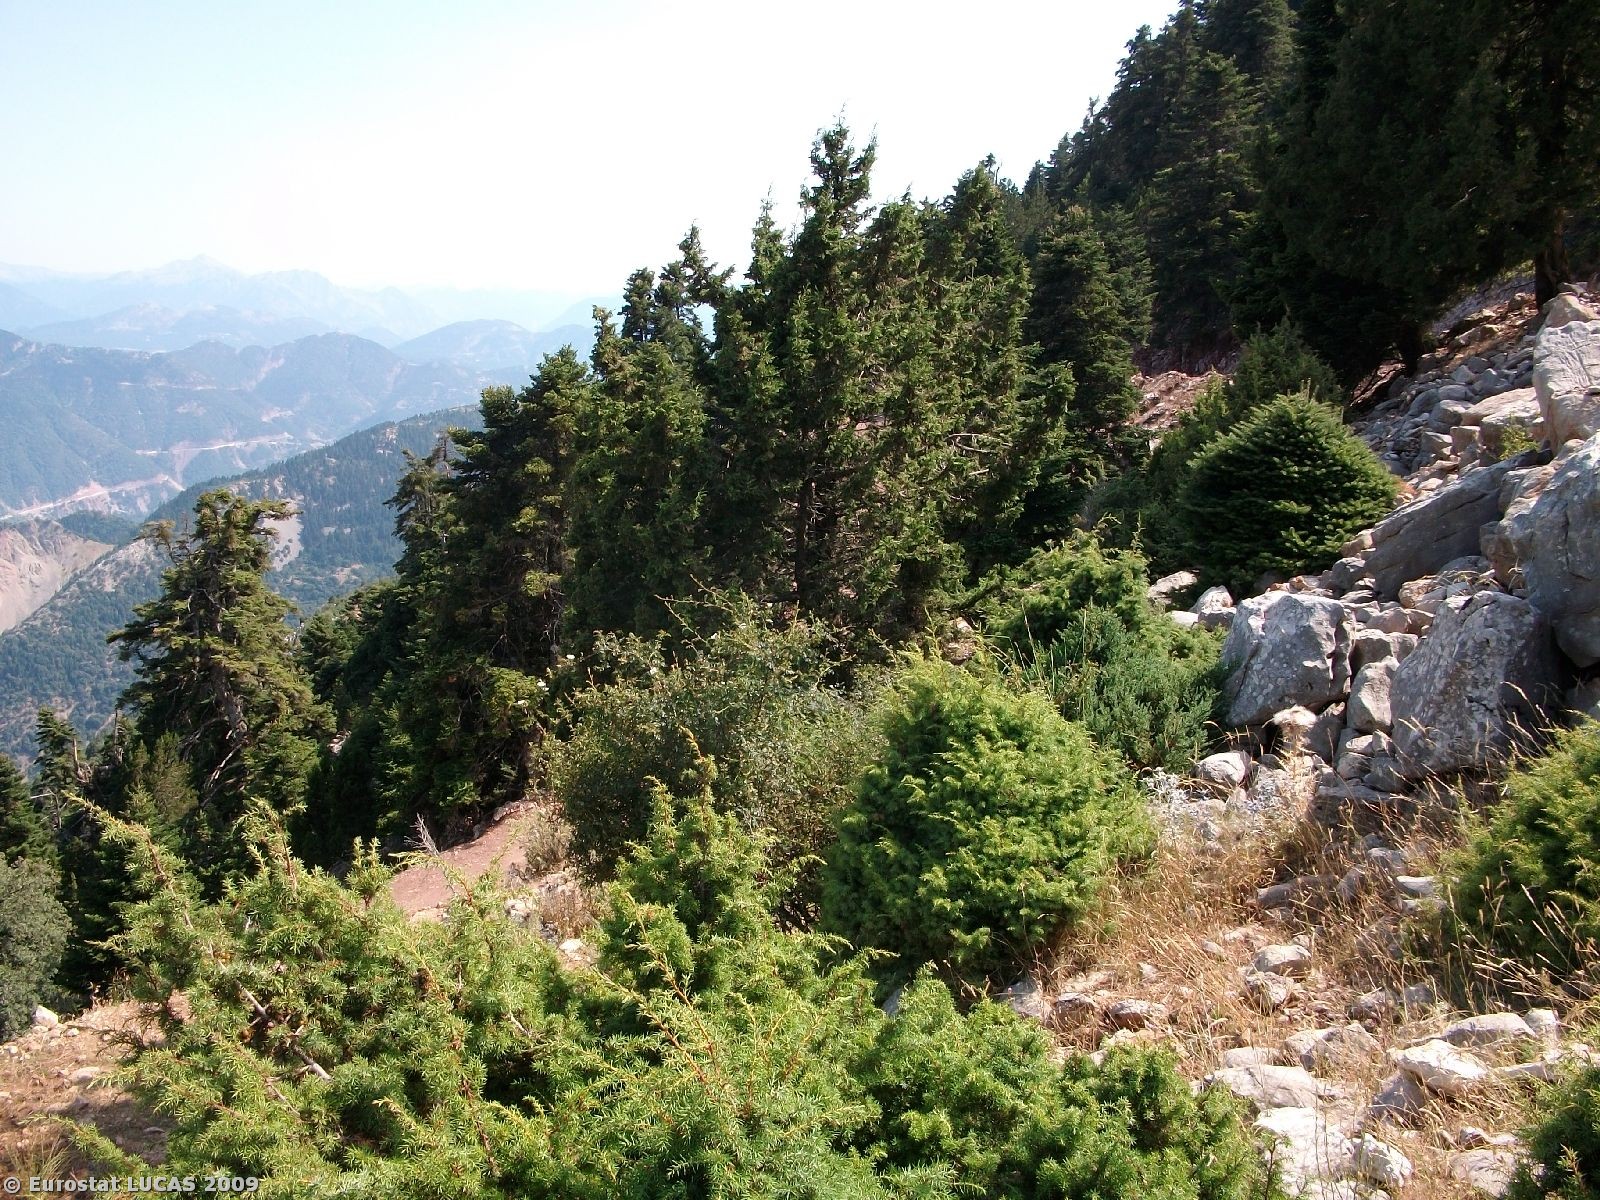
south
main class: Artificial land
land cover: Non built-up linear features
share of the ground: 50 - 75 %
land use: Water supply and treatment
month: August
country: GR
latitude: 39.0690
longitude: 21.5689
